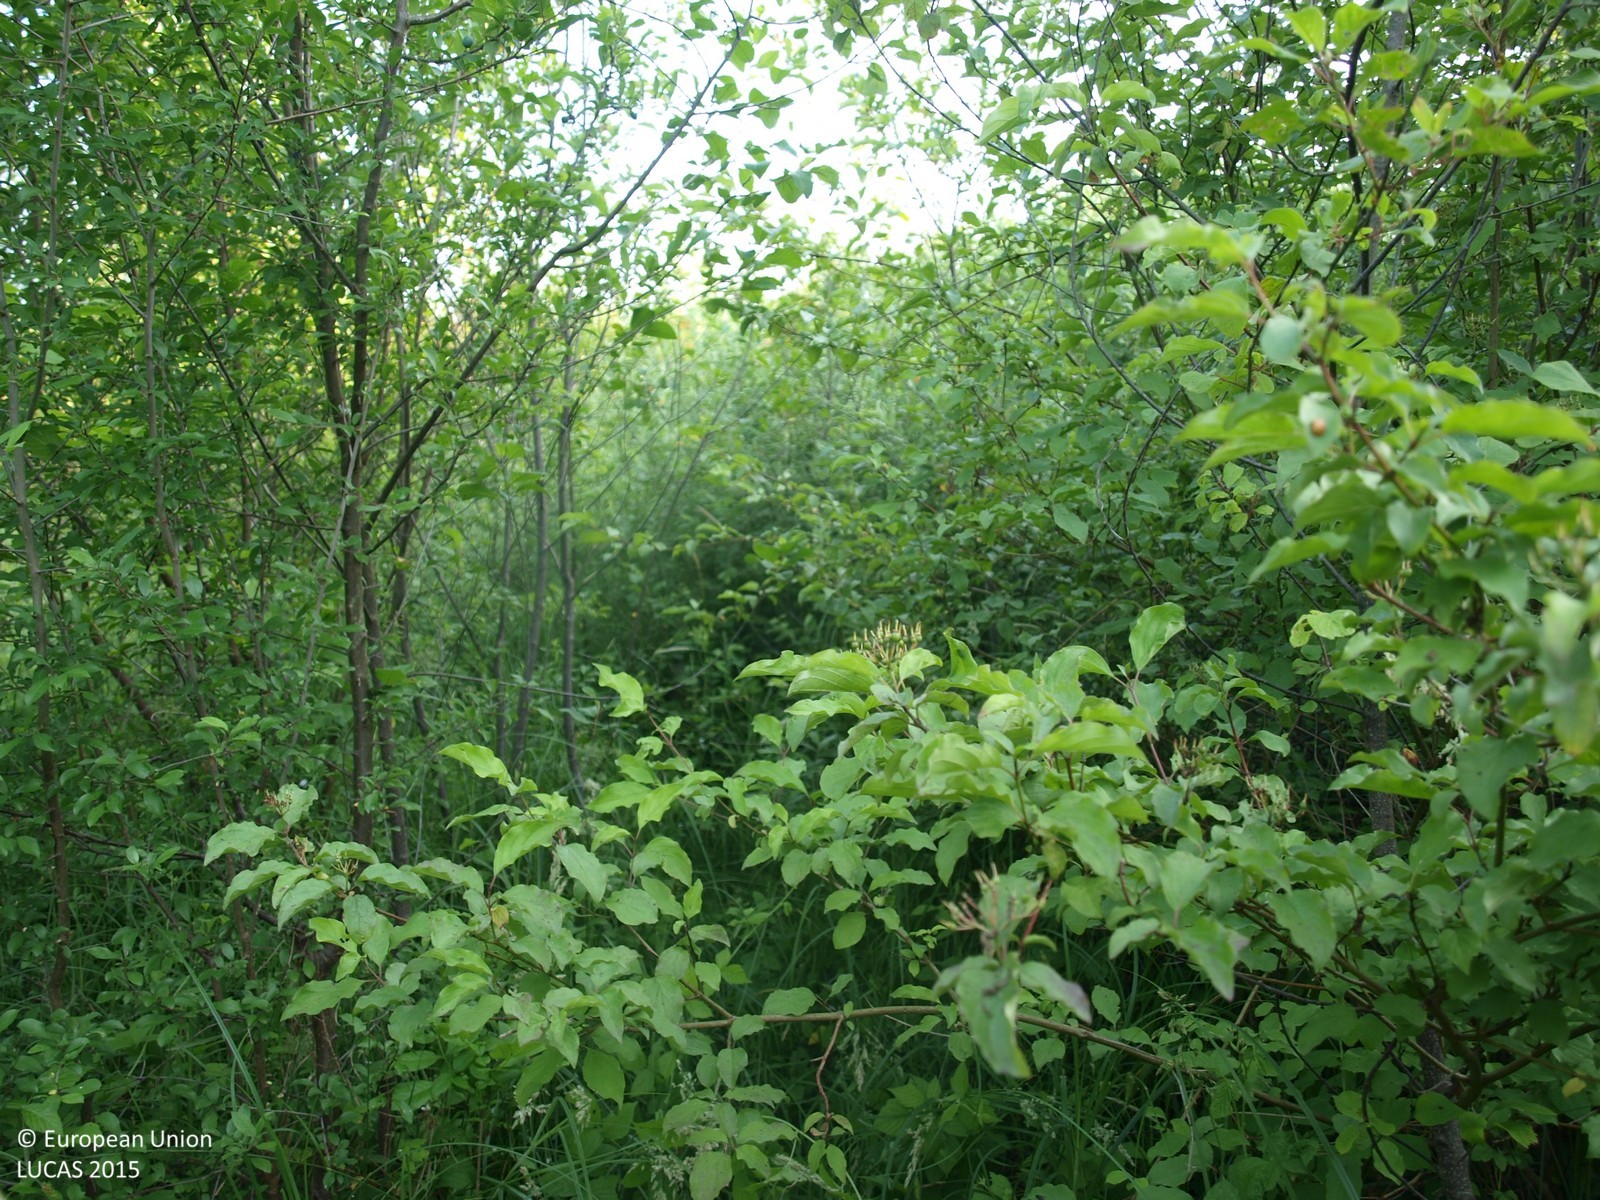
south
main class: Shrubland
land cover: Shrubland with sparse tree cover
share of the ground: > 75 %
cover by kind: shrubs 95 %, broadleaved forest trees 5 %
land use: Abandoned areas
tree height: > 5 m
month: June
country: HR
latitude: 45.7993
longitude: 15.7485
